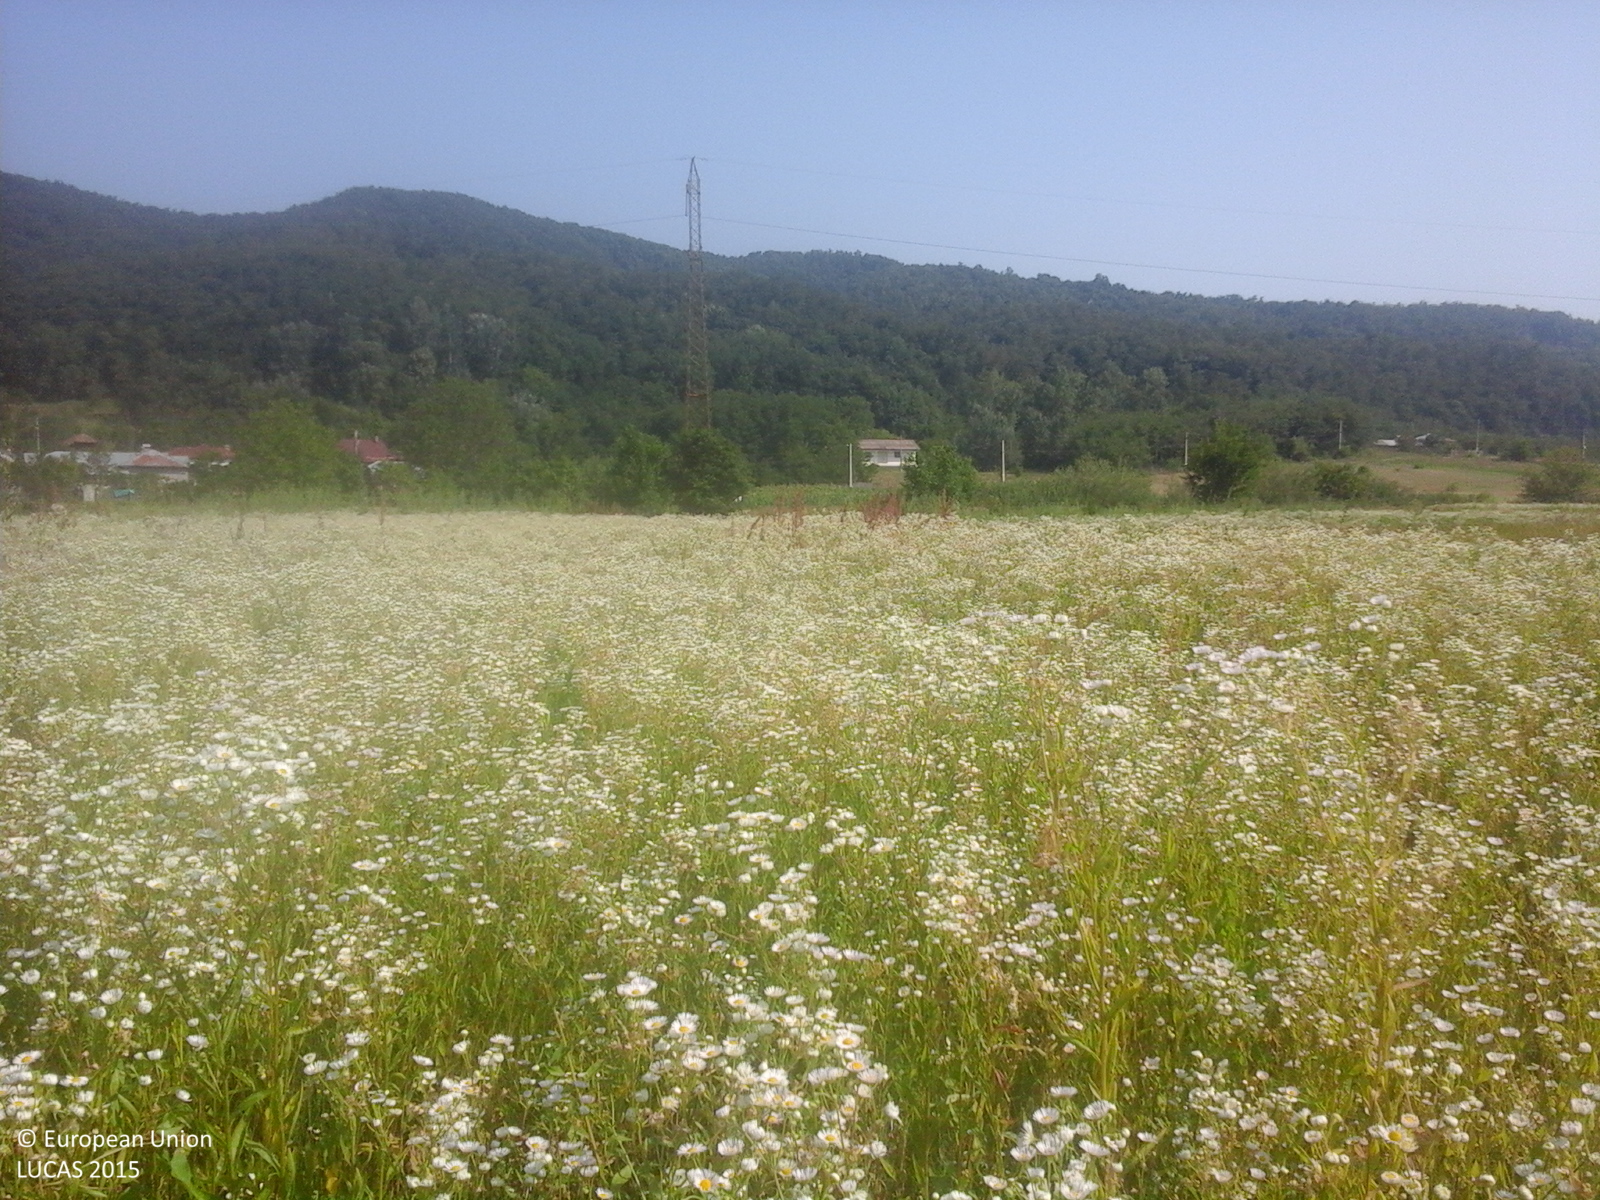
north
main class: Grassland
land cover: Spontaneously vegetated surfaces
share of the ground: > 75 %
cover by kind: herbaceous plants 100 %
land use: Fallow land
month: July
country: RO
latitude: 44.9983
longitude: 24.4470
